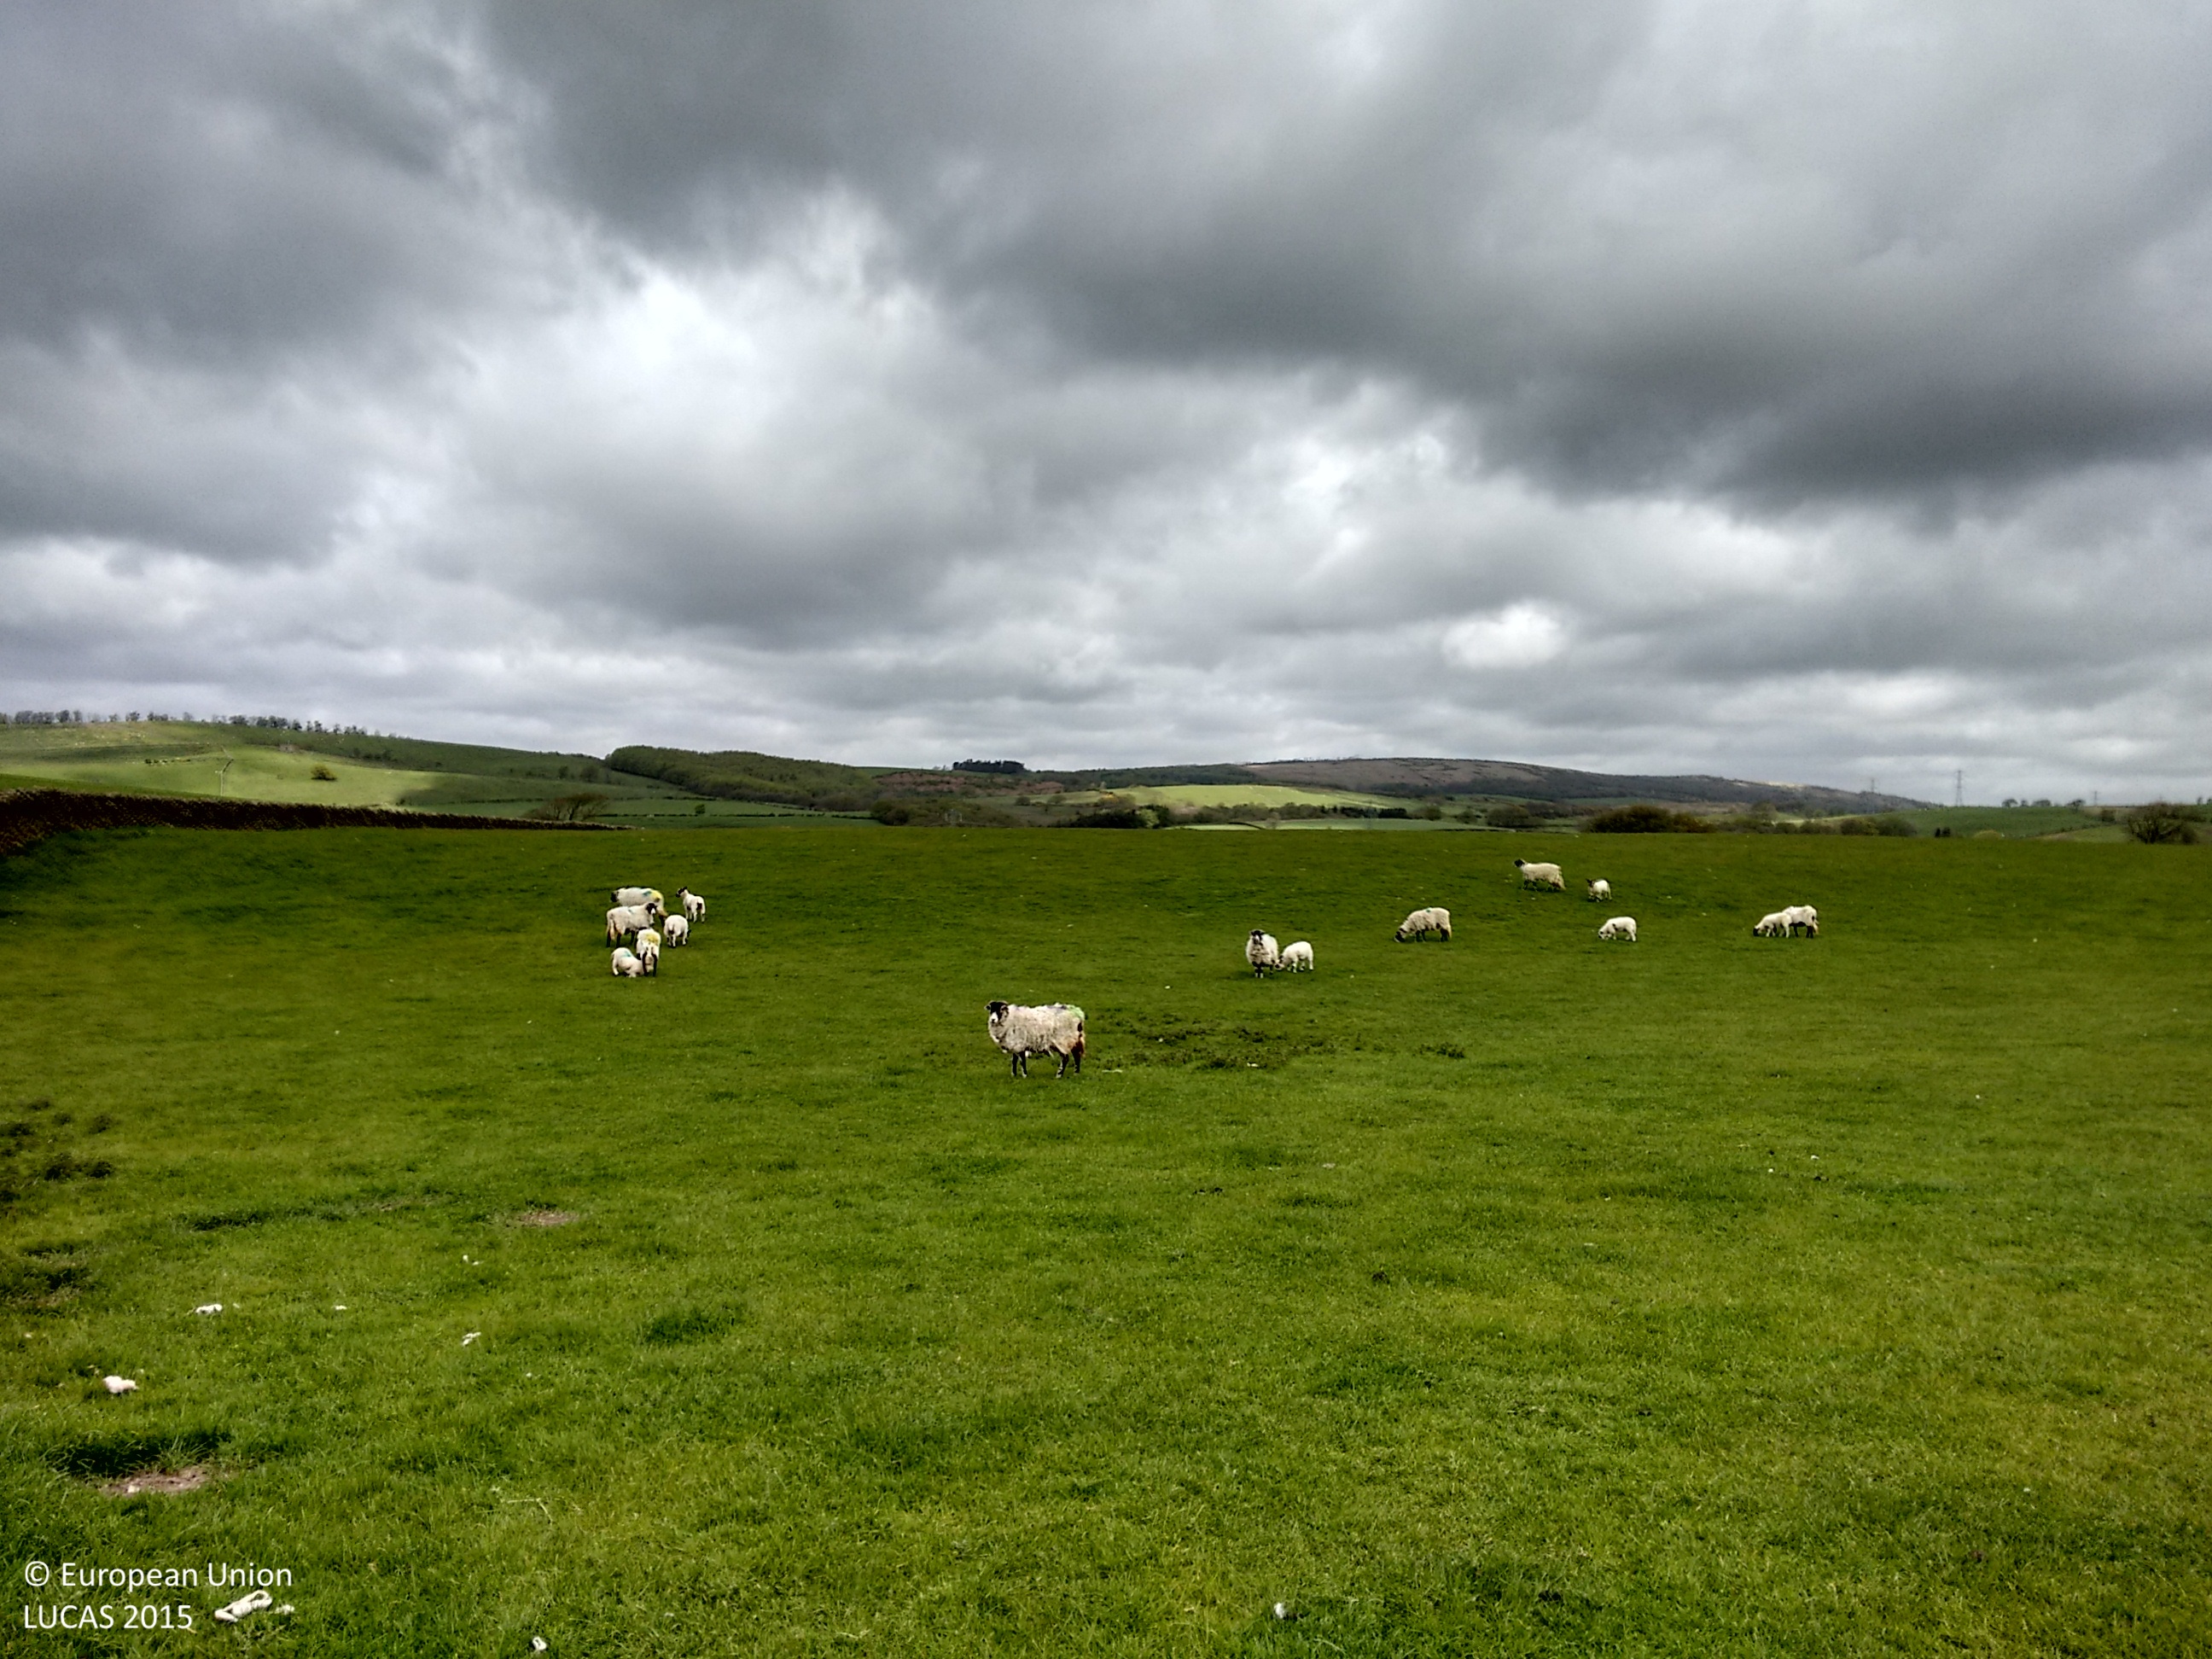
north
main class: Grassland
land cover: Grassland without tree/shrub cover
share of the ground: > 75 %
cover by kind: herbaceous plants 100 %
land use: Agriculture (excluding fallow land and kitchen gardens)
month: May
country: GB
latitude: 54.1537
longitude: -2.6692
